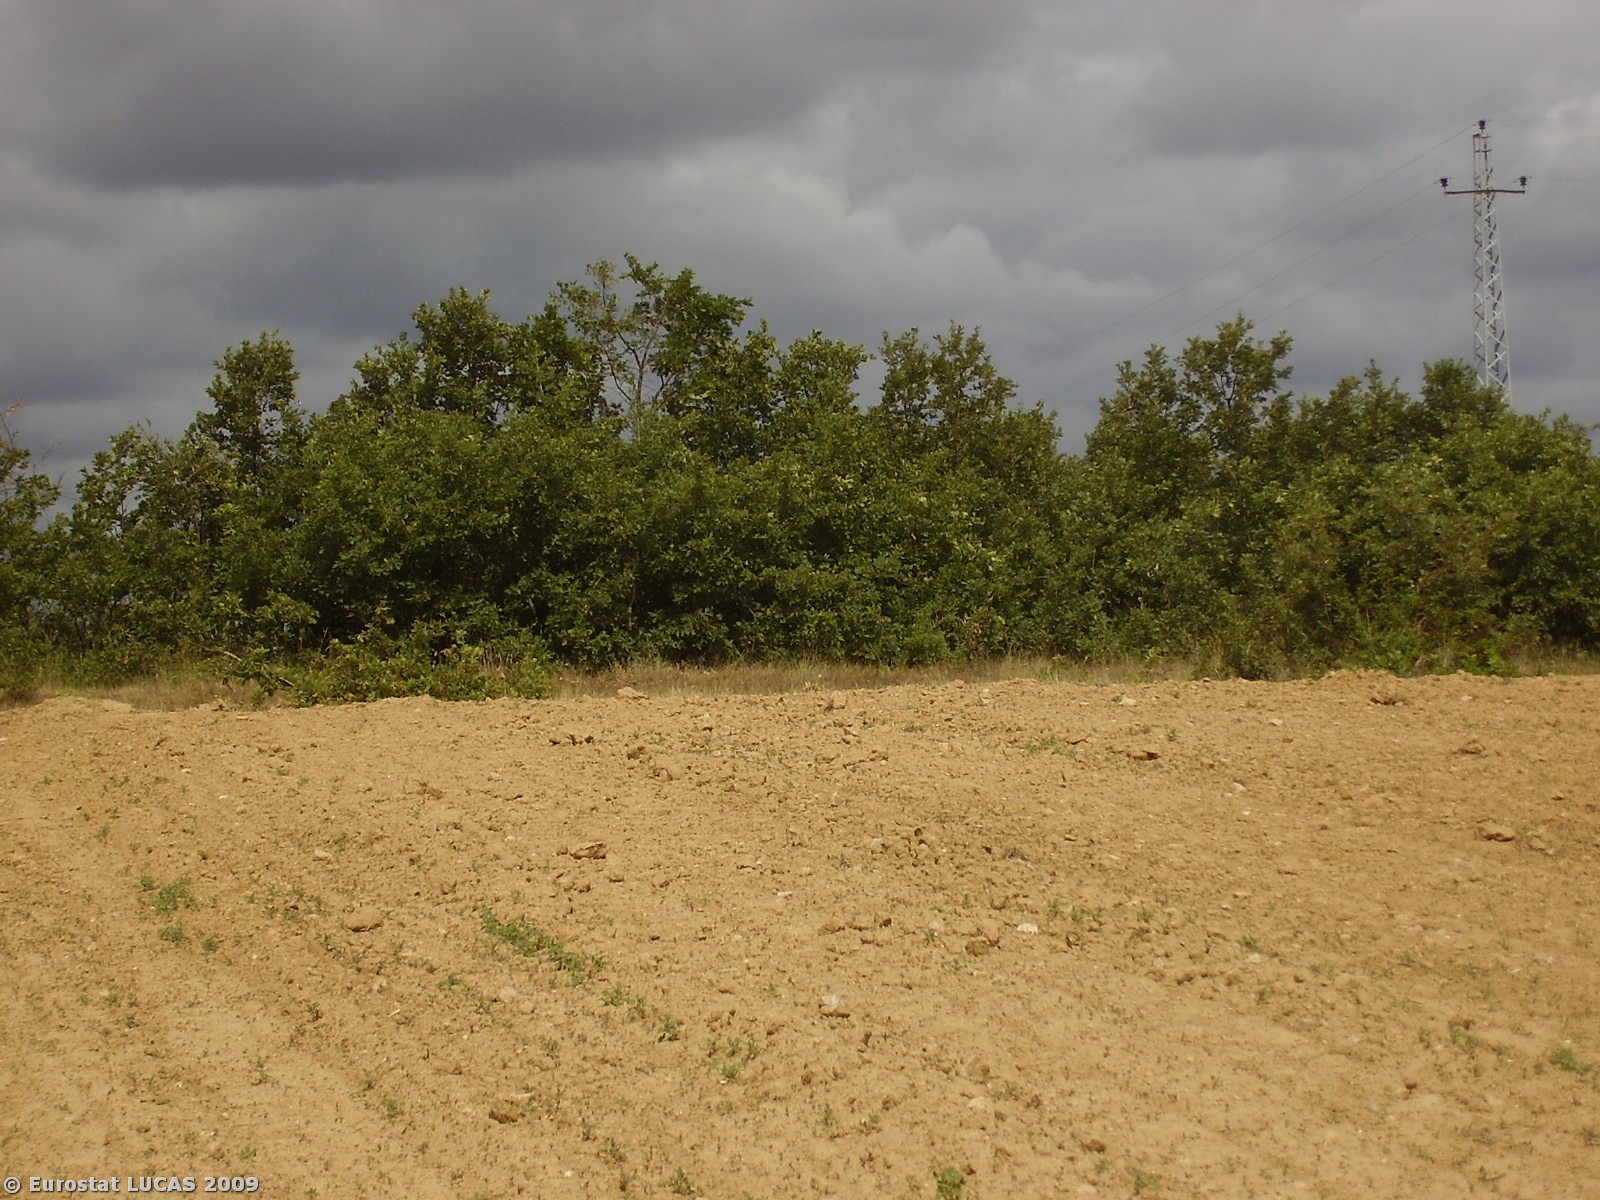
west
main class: Cropland
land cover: Other fresh vegetables
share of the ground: < 10 %
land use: Agriculture (excluding fallow land and kitchen gardens)
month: June
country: PT
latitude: 41.5371
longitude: -6.3411
